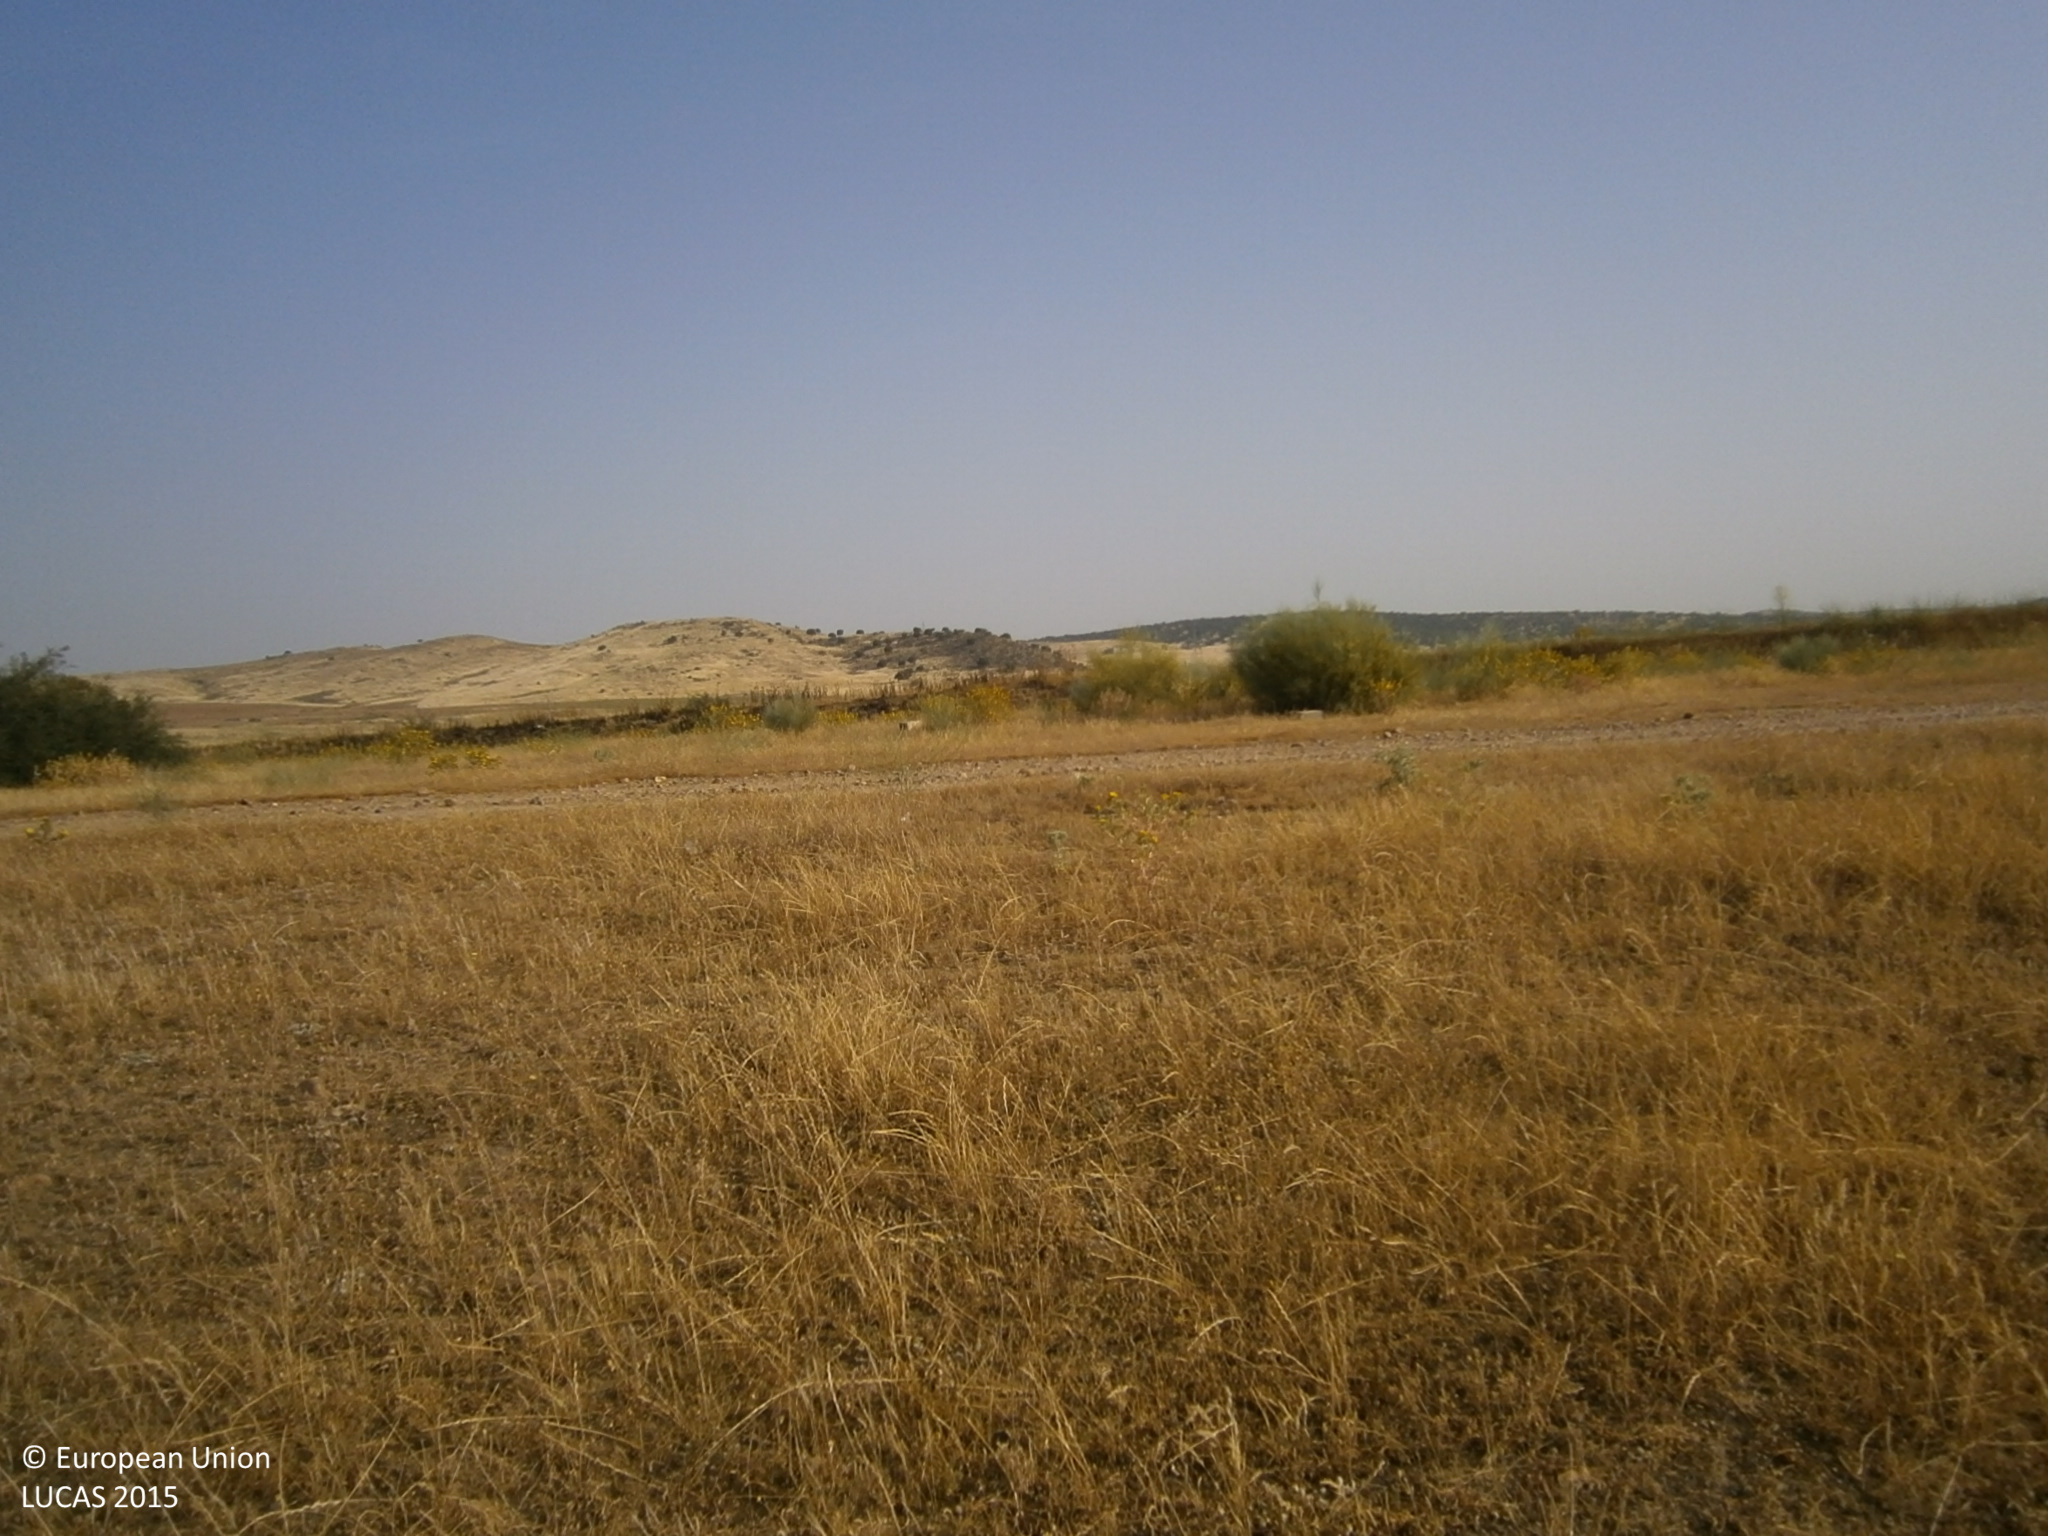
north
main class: Grassland
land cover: Grassland without tree/shrub cover
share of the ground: > 75 %
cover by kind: herbaceous plants 100 %
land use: Abandoned areas
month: June
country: ES
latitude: 38.8698
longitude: -6.2250
